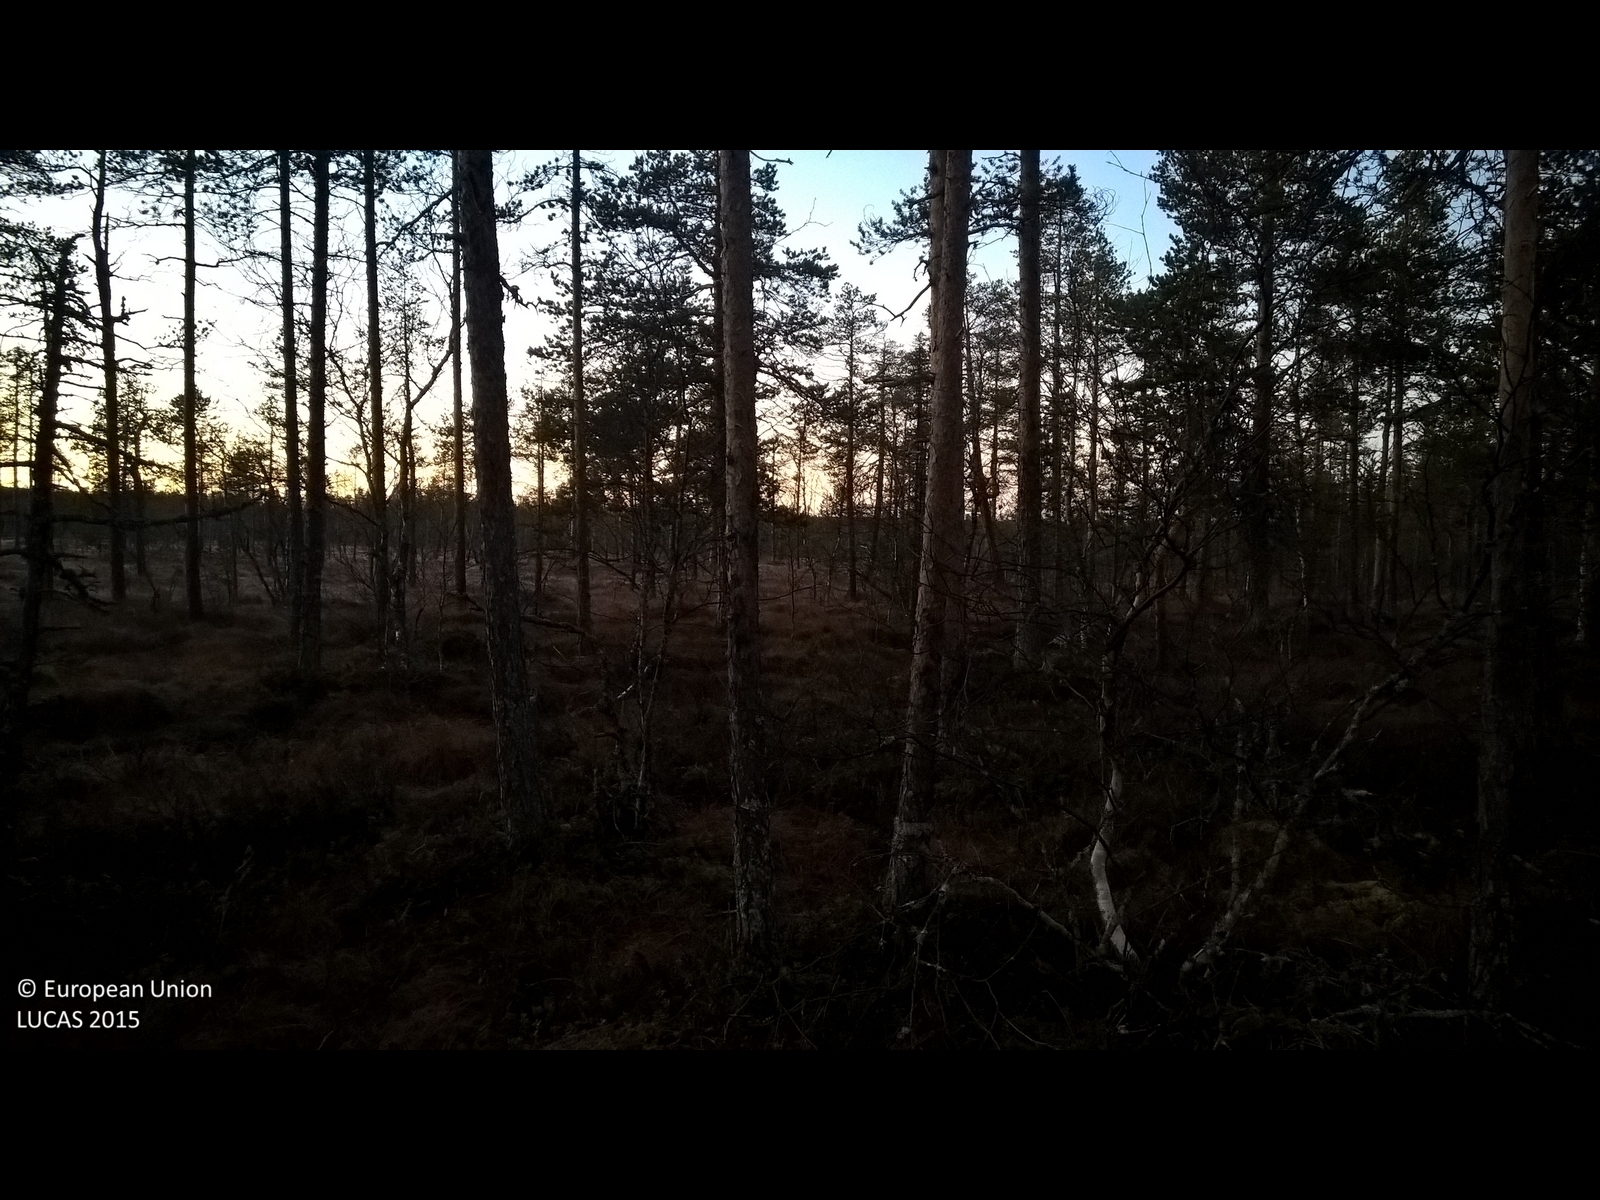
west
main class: Woodland
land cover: Pine dominated coniferous woodland
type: mire and swamp forests
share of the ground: 25 - 50 %
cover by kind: coniferous forest trees 40 %, shrubs 20 %, herbaceous plants 20 %, lichens and mosses 20 %
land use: Forestry
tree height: > 5 m
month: November
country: SE
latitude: 62.3509
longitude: 13.6738
